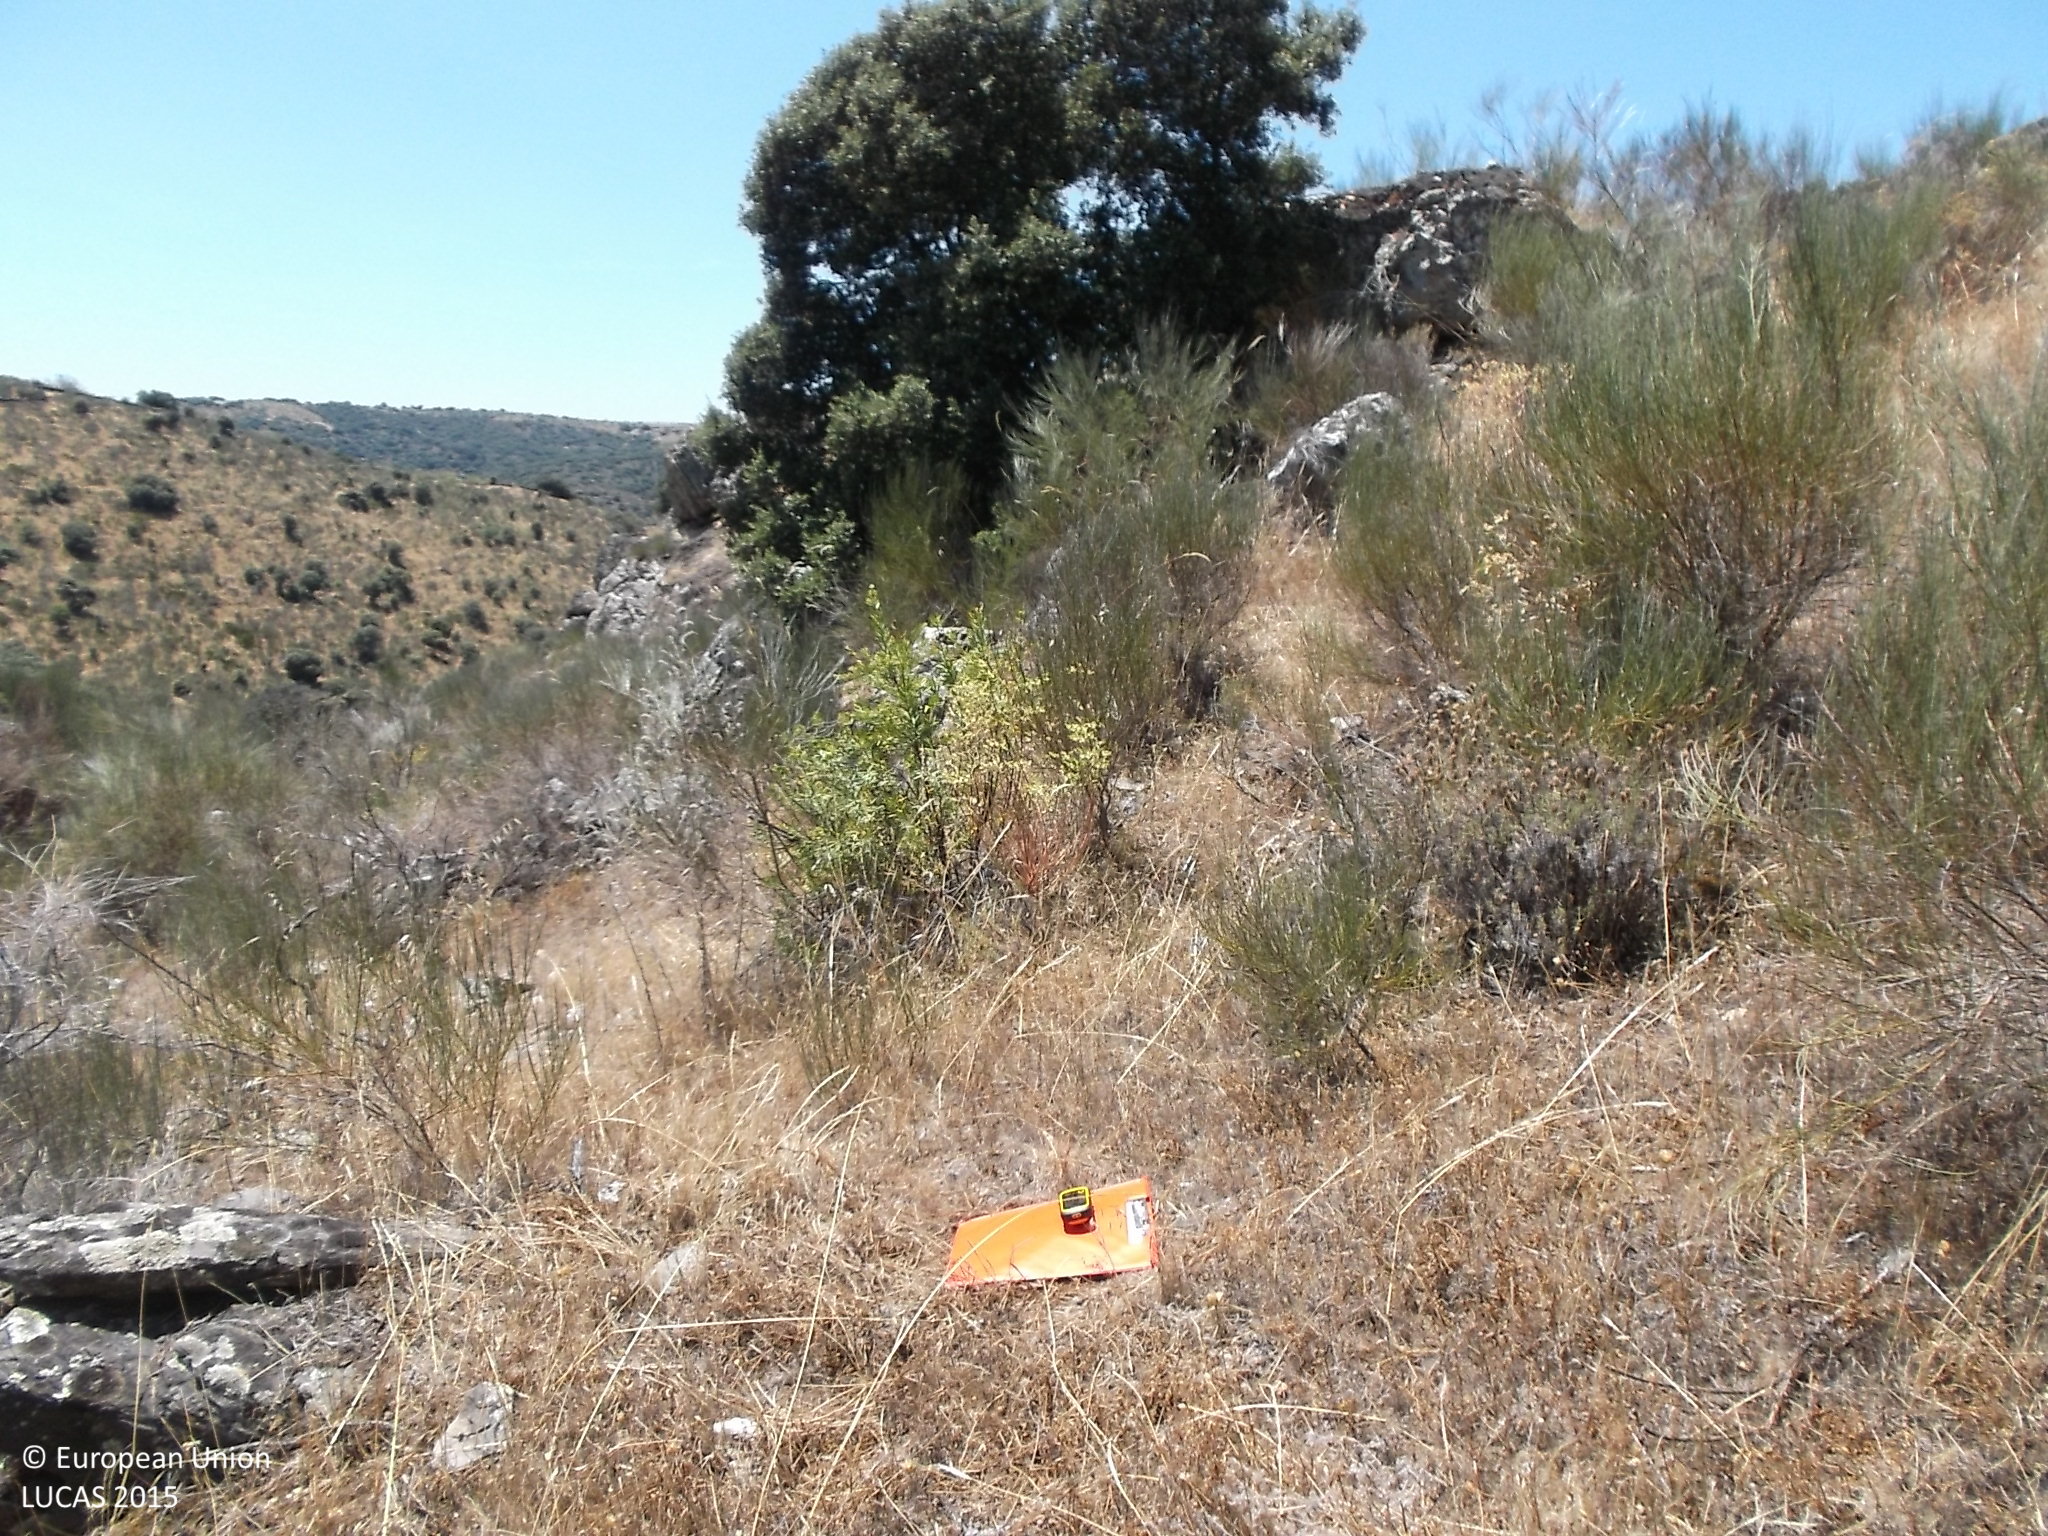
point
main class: Shrubland
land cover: Shrubland without tree cover
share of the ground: > 75 %
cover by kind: shrubs 90 %, herbaceous plants 10 %
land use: Agriculture (excluding fallow land and kitchen gardens)
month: July
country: ES
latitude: 41.0123
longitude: -6.8333
